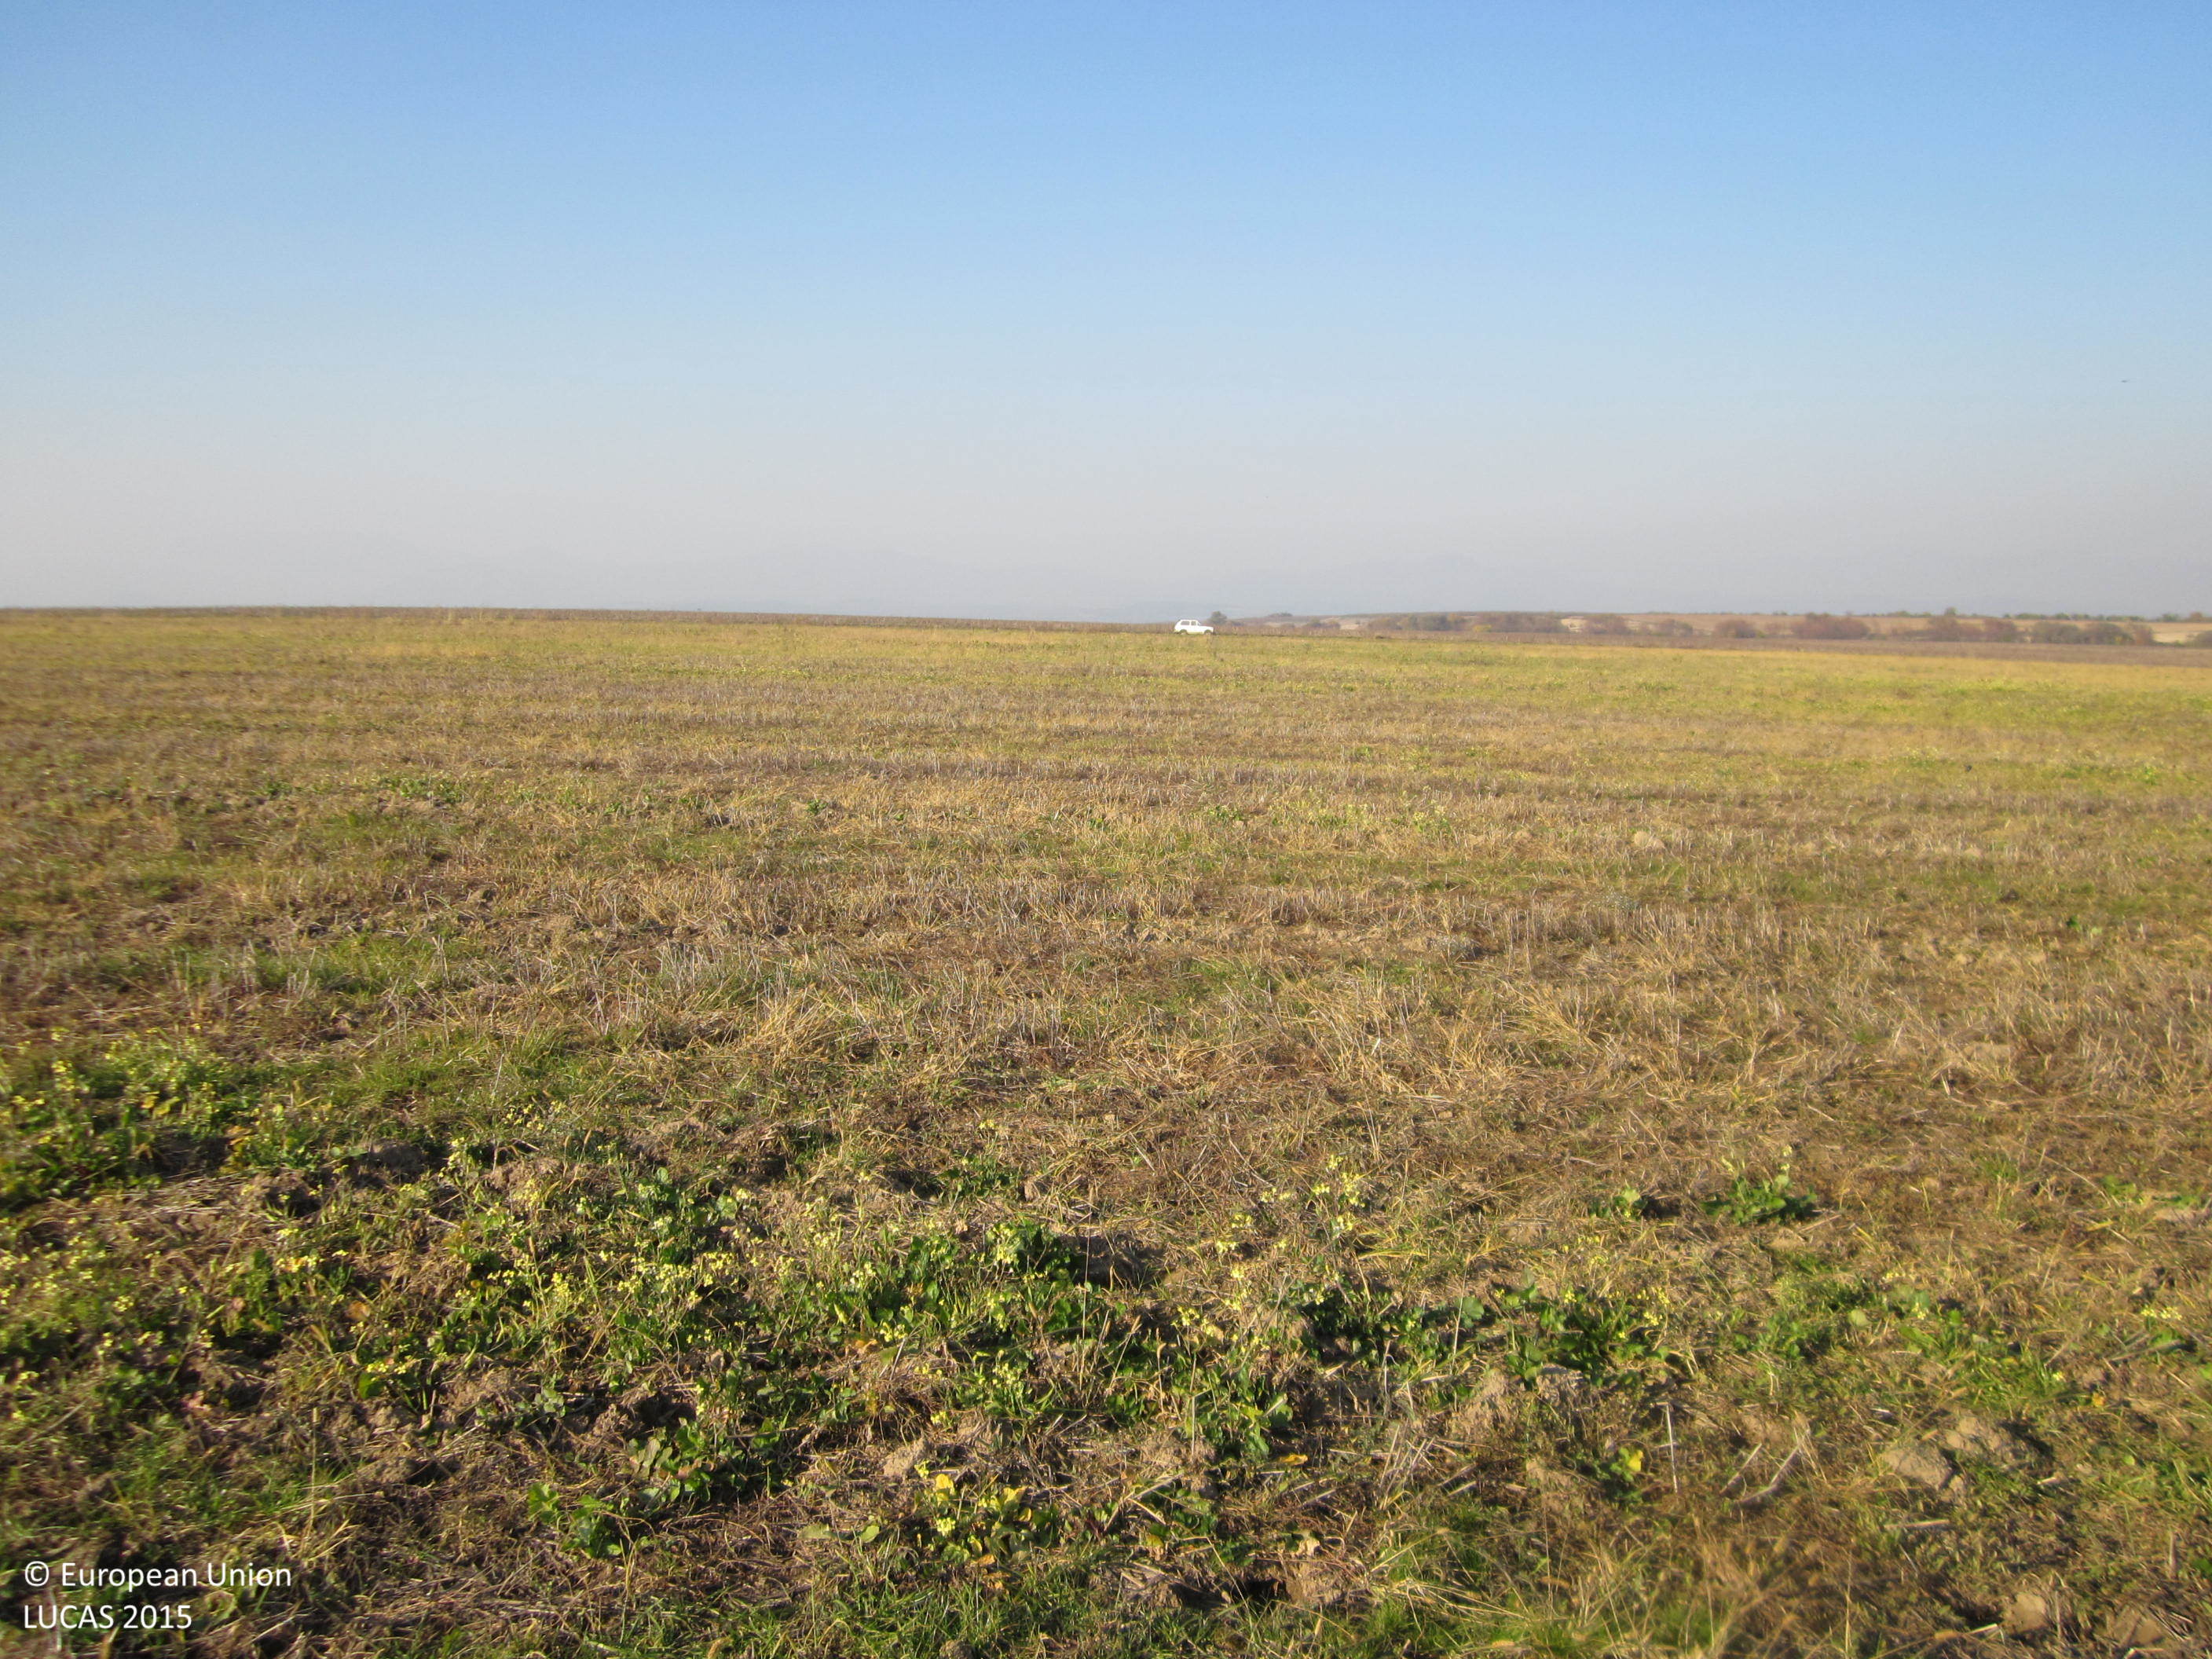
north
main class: Cropland
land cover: Common wheat
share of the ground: 10 - 25 %
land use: Agriculture (excluding fallow land and kitchen gardens)
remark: Tilled/Sowed
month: November
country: BG
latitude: 42.4181
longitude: 24.6976
